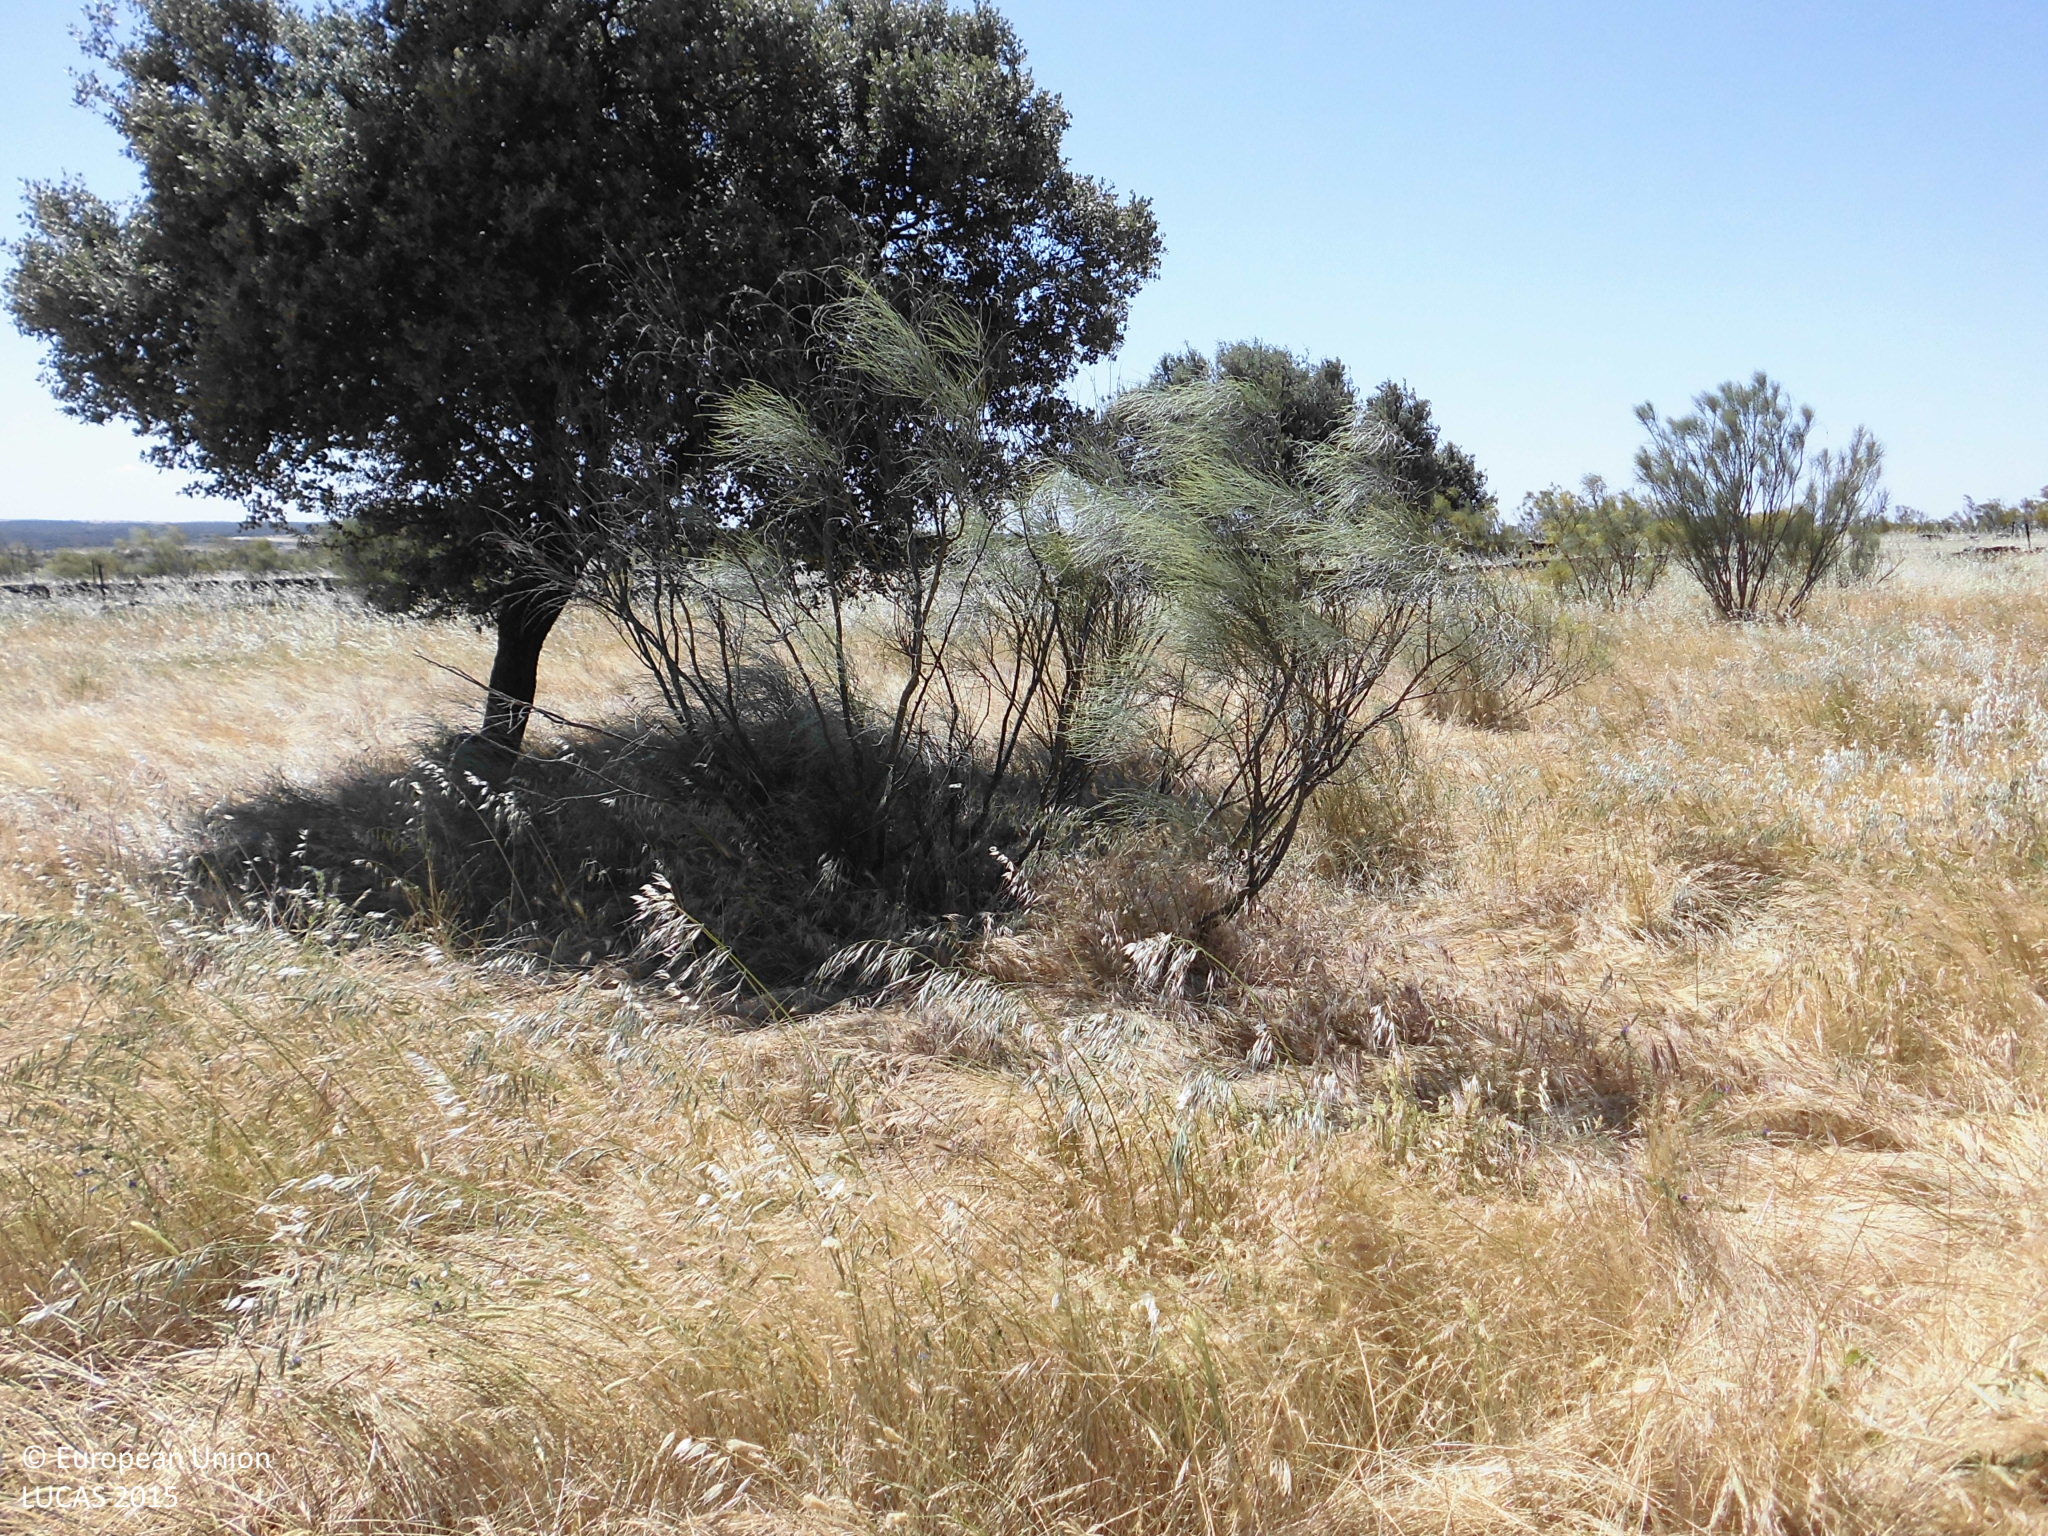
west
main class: Grassland
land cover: Grassland with sparse tree/shrub cover
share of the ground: > 75 %
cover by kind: herbaceous plants 90 %, broadleaved forest trees 5 %, shrubs 5 %
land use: Agriculture (excluding fallow land and kitchen gardens)
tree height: > 5 m
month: May
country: ES
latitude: 39.3396
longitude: -6.0591
